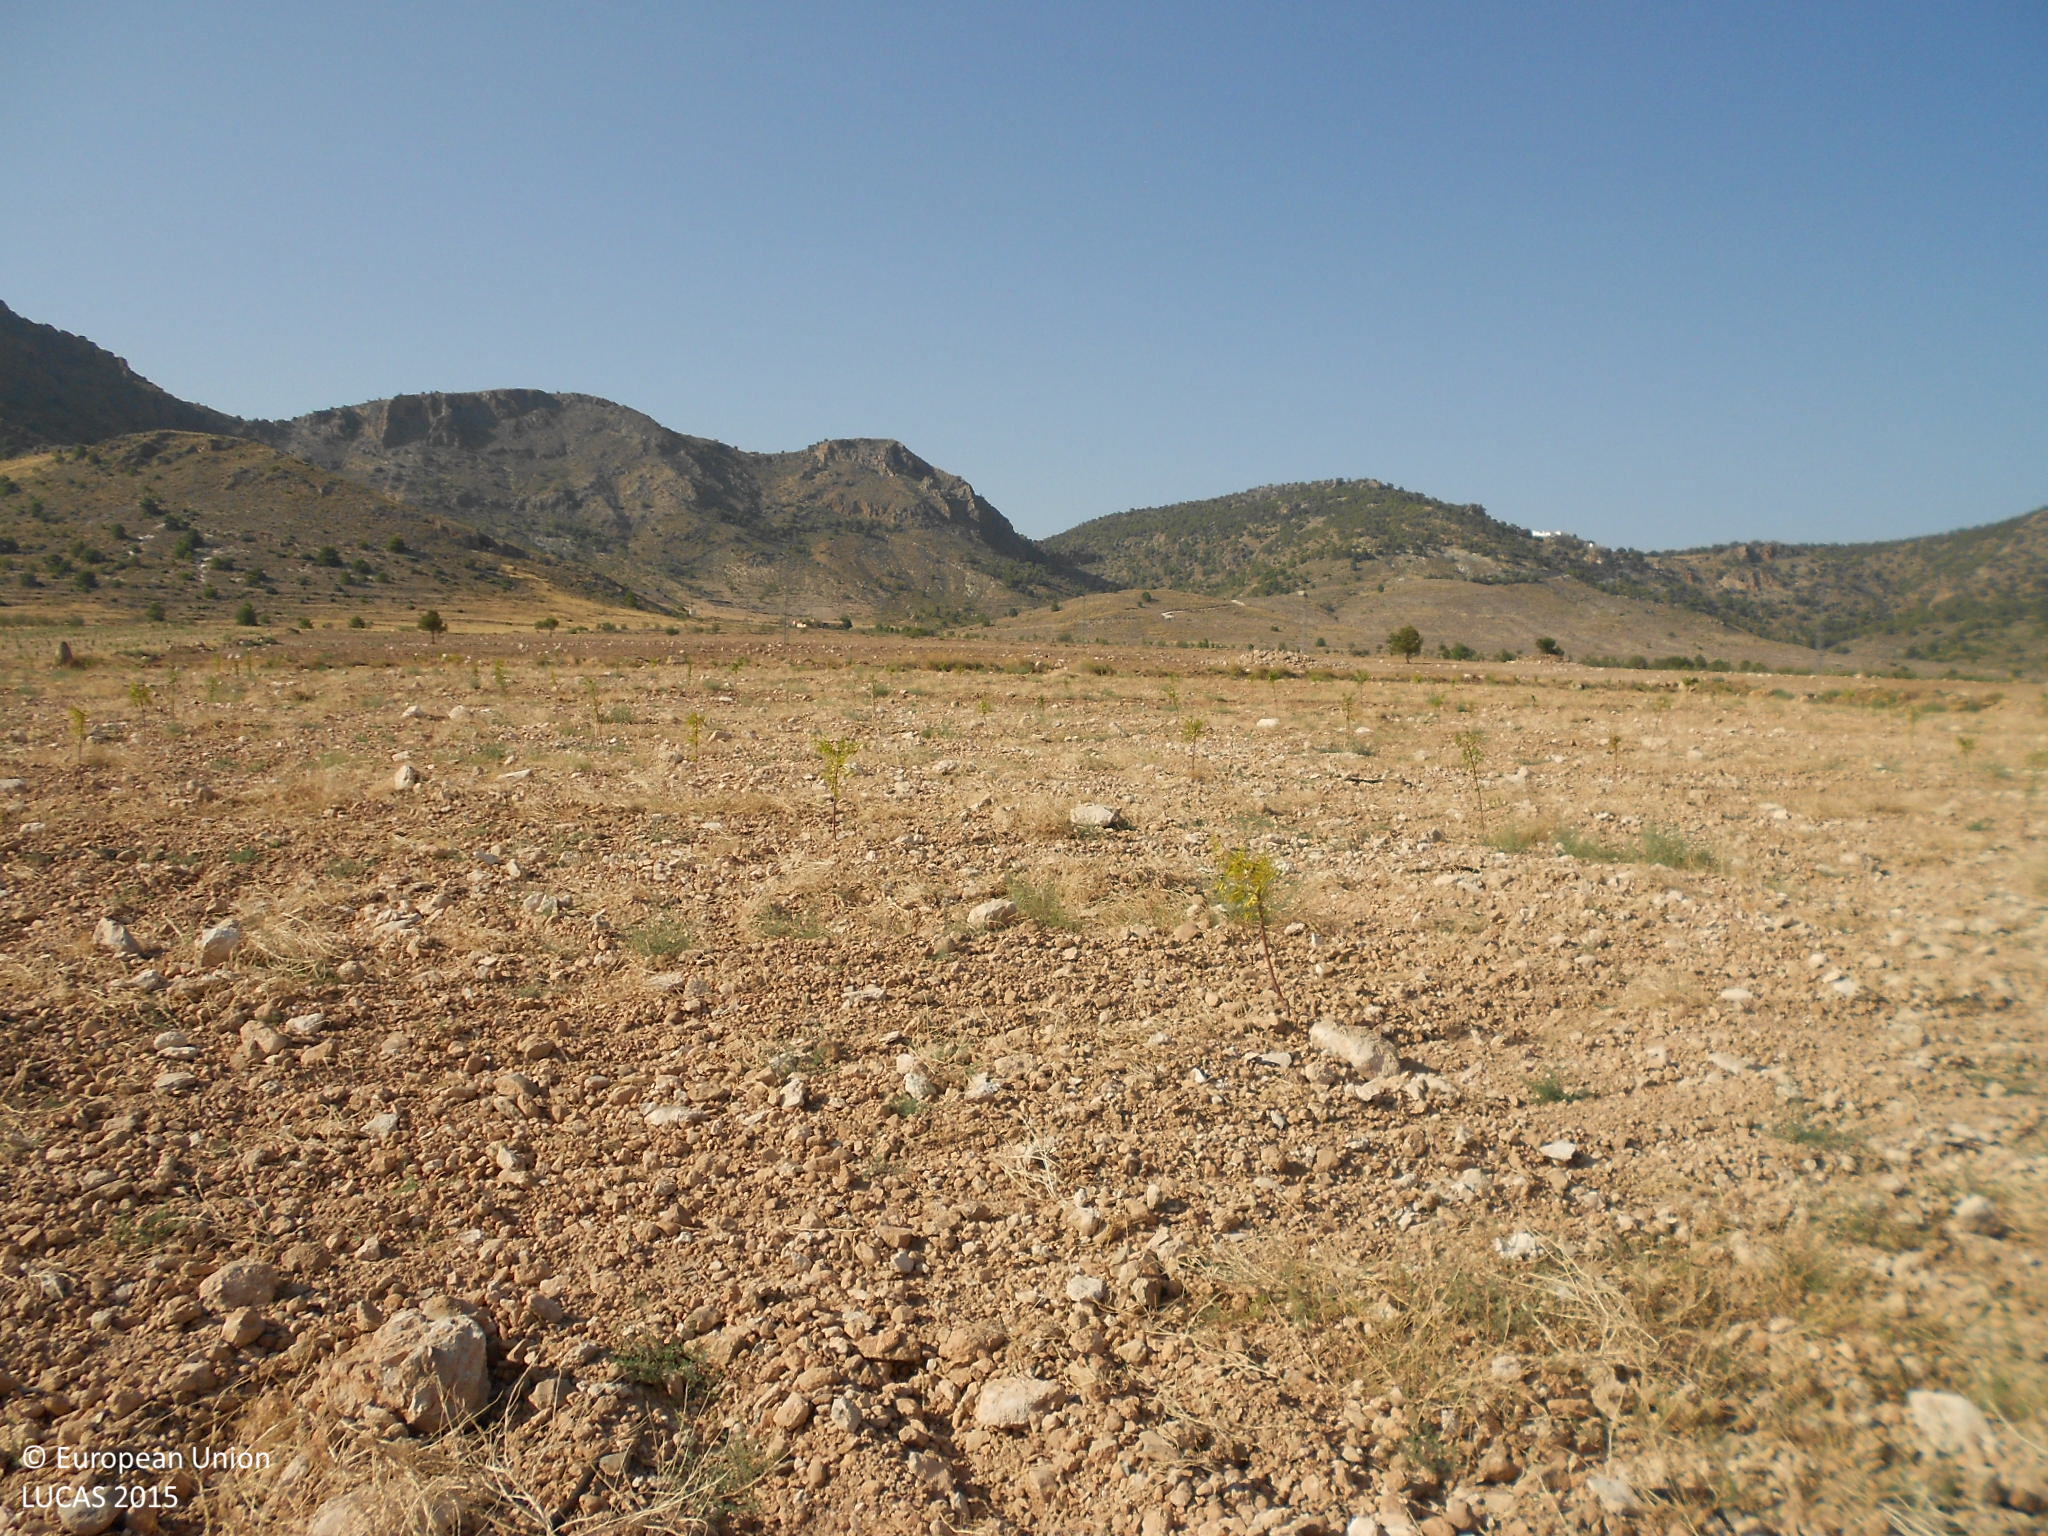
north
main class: Cropland
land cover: Nuts trees
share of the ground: < 10 %
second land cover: Other bare soil
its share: > 75 %
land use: Agriculture (excluding fallow land and kitchen gardens)
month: July
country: ES
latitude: 37.4716
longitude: -2.3425
